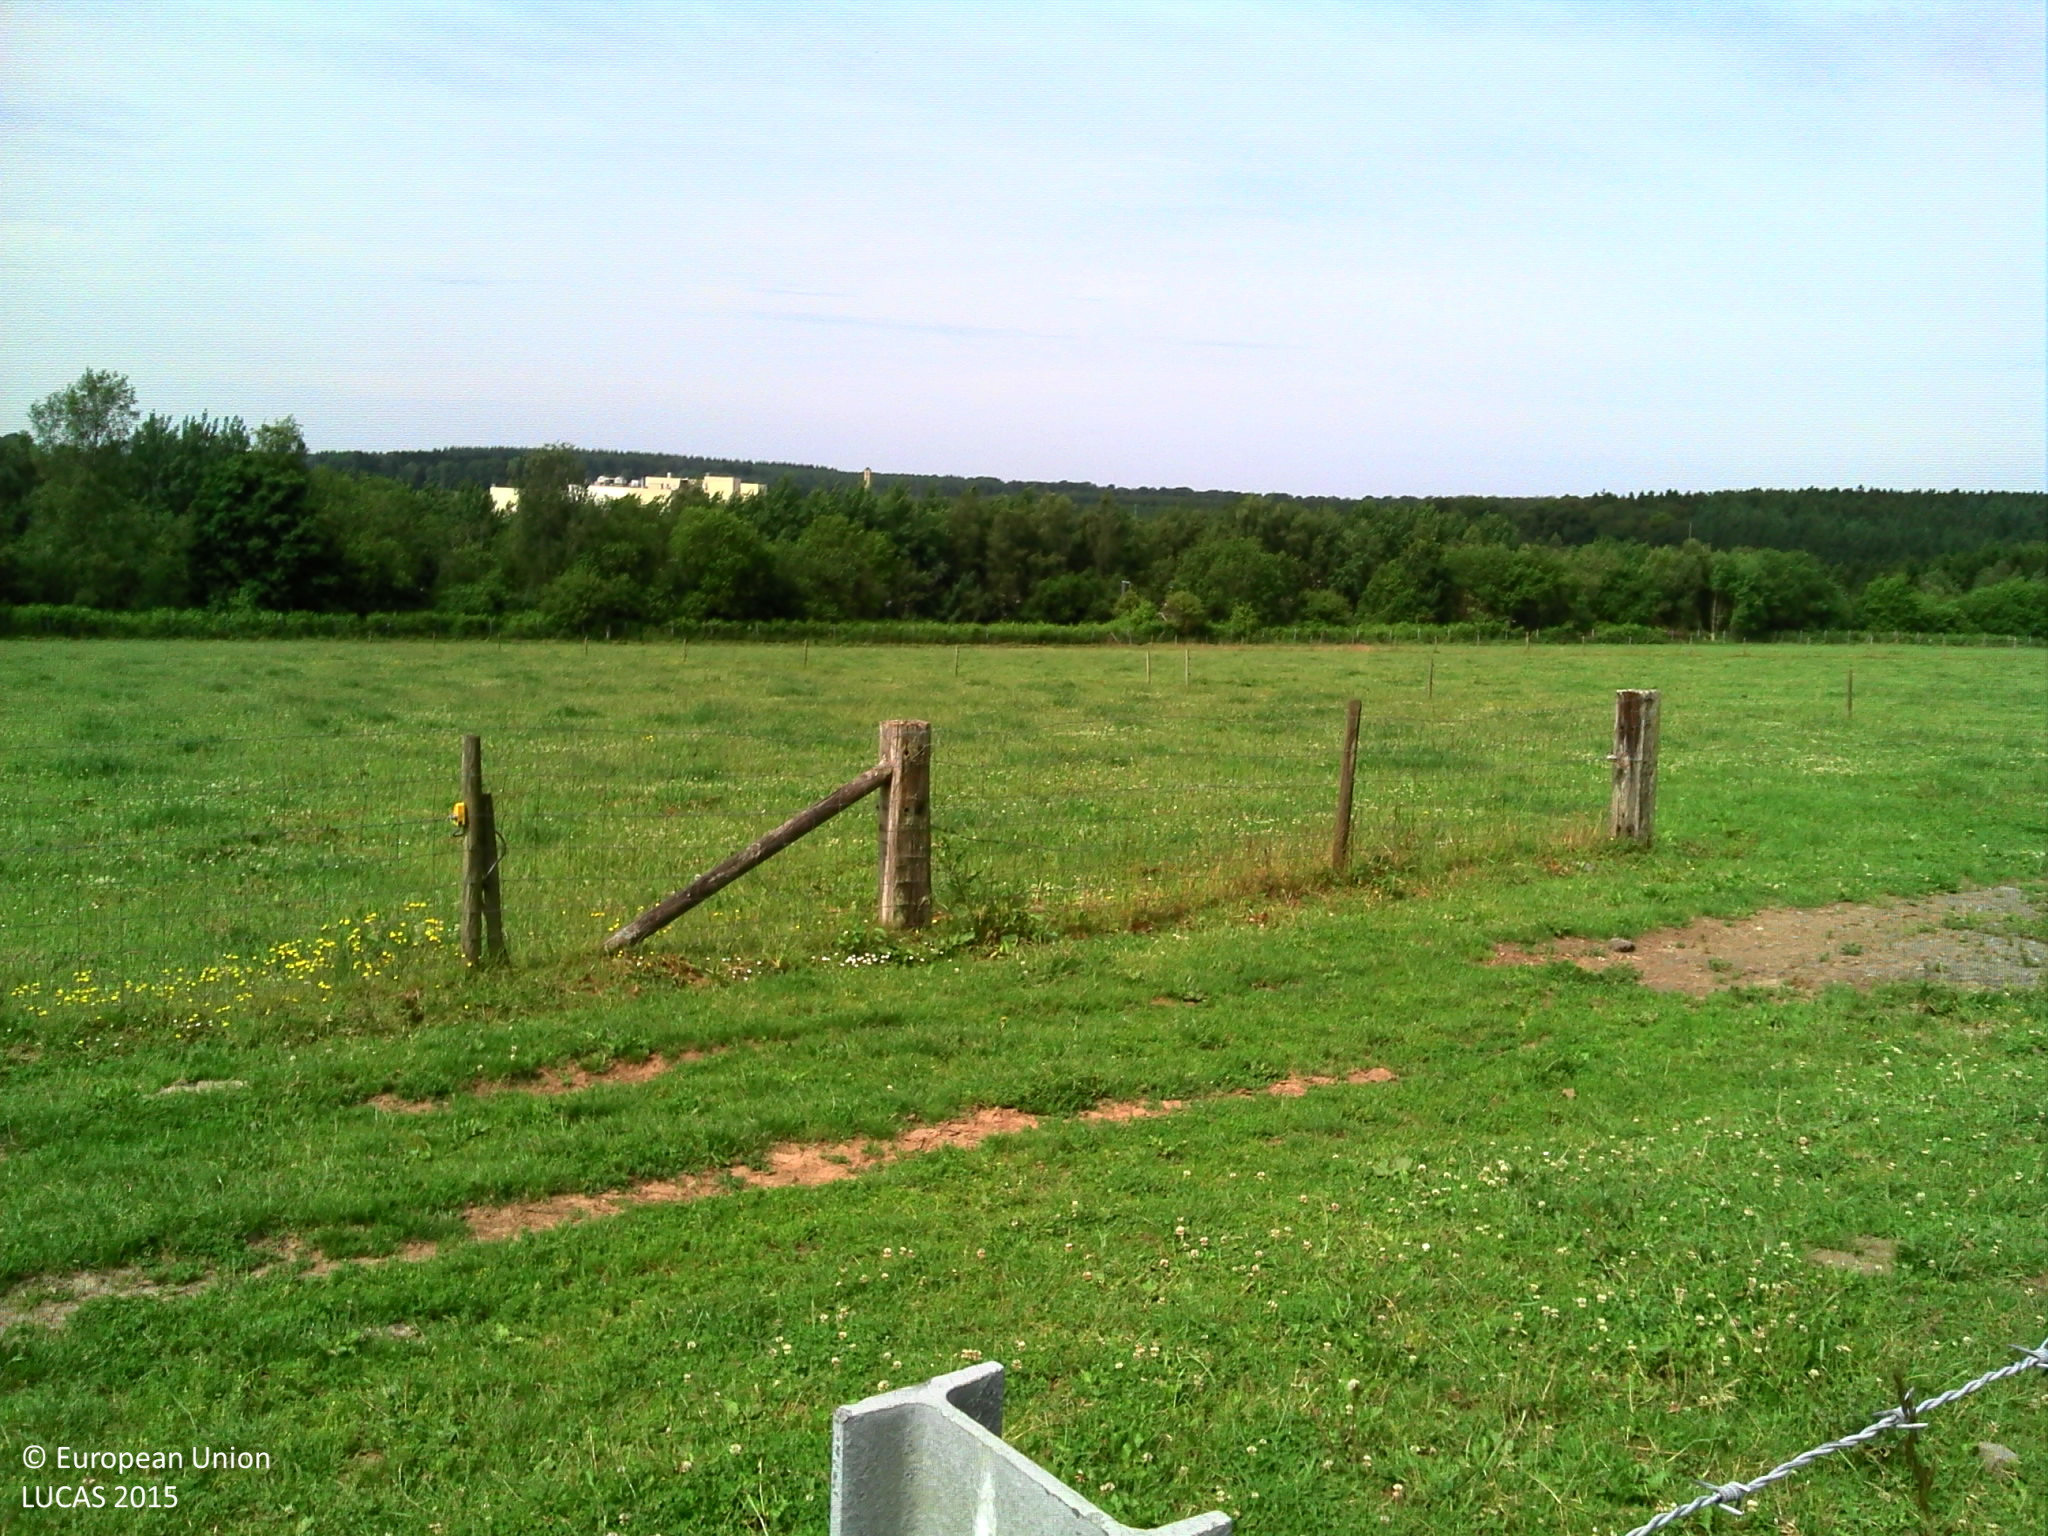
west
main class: Grassland
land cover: Grassland without tree/shrub cover
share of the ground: > 75 %
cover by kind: herbaceous plants 100 %
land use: Agriculture (excluding fallow land and kitchen gardens)
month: June
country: BE
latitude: 49.9277
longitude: 5.3593
